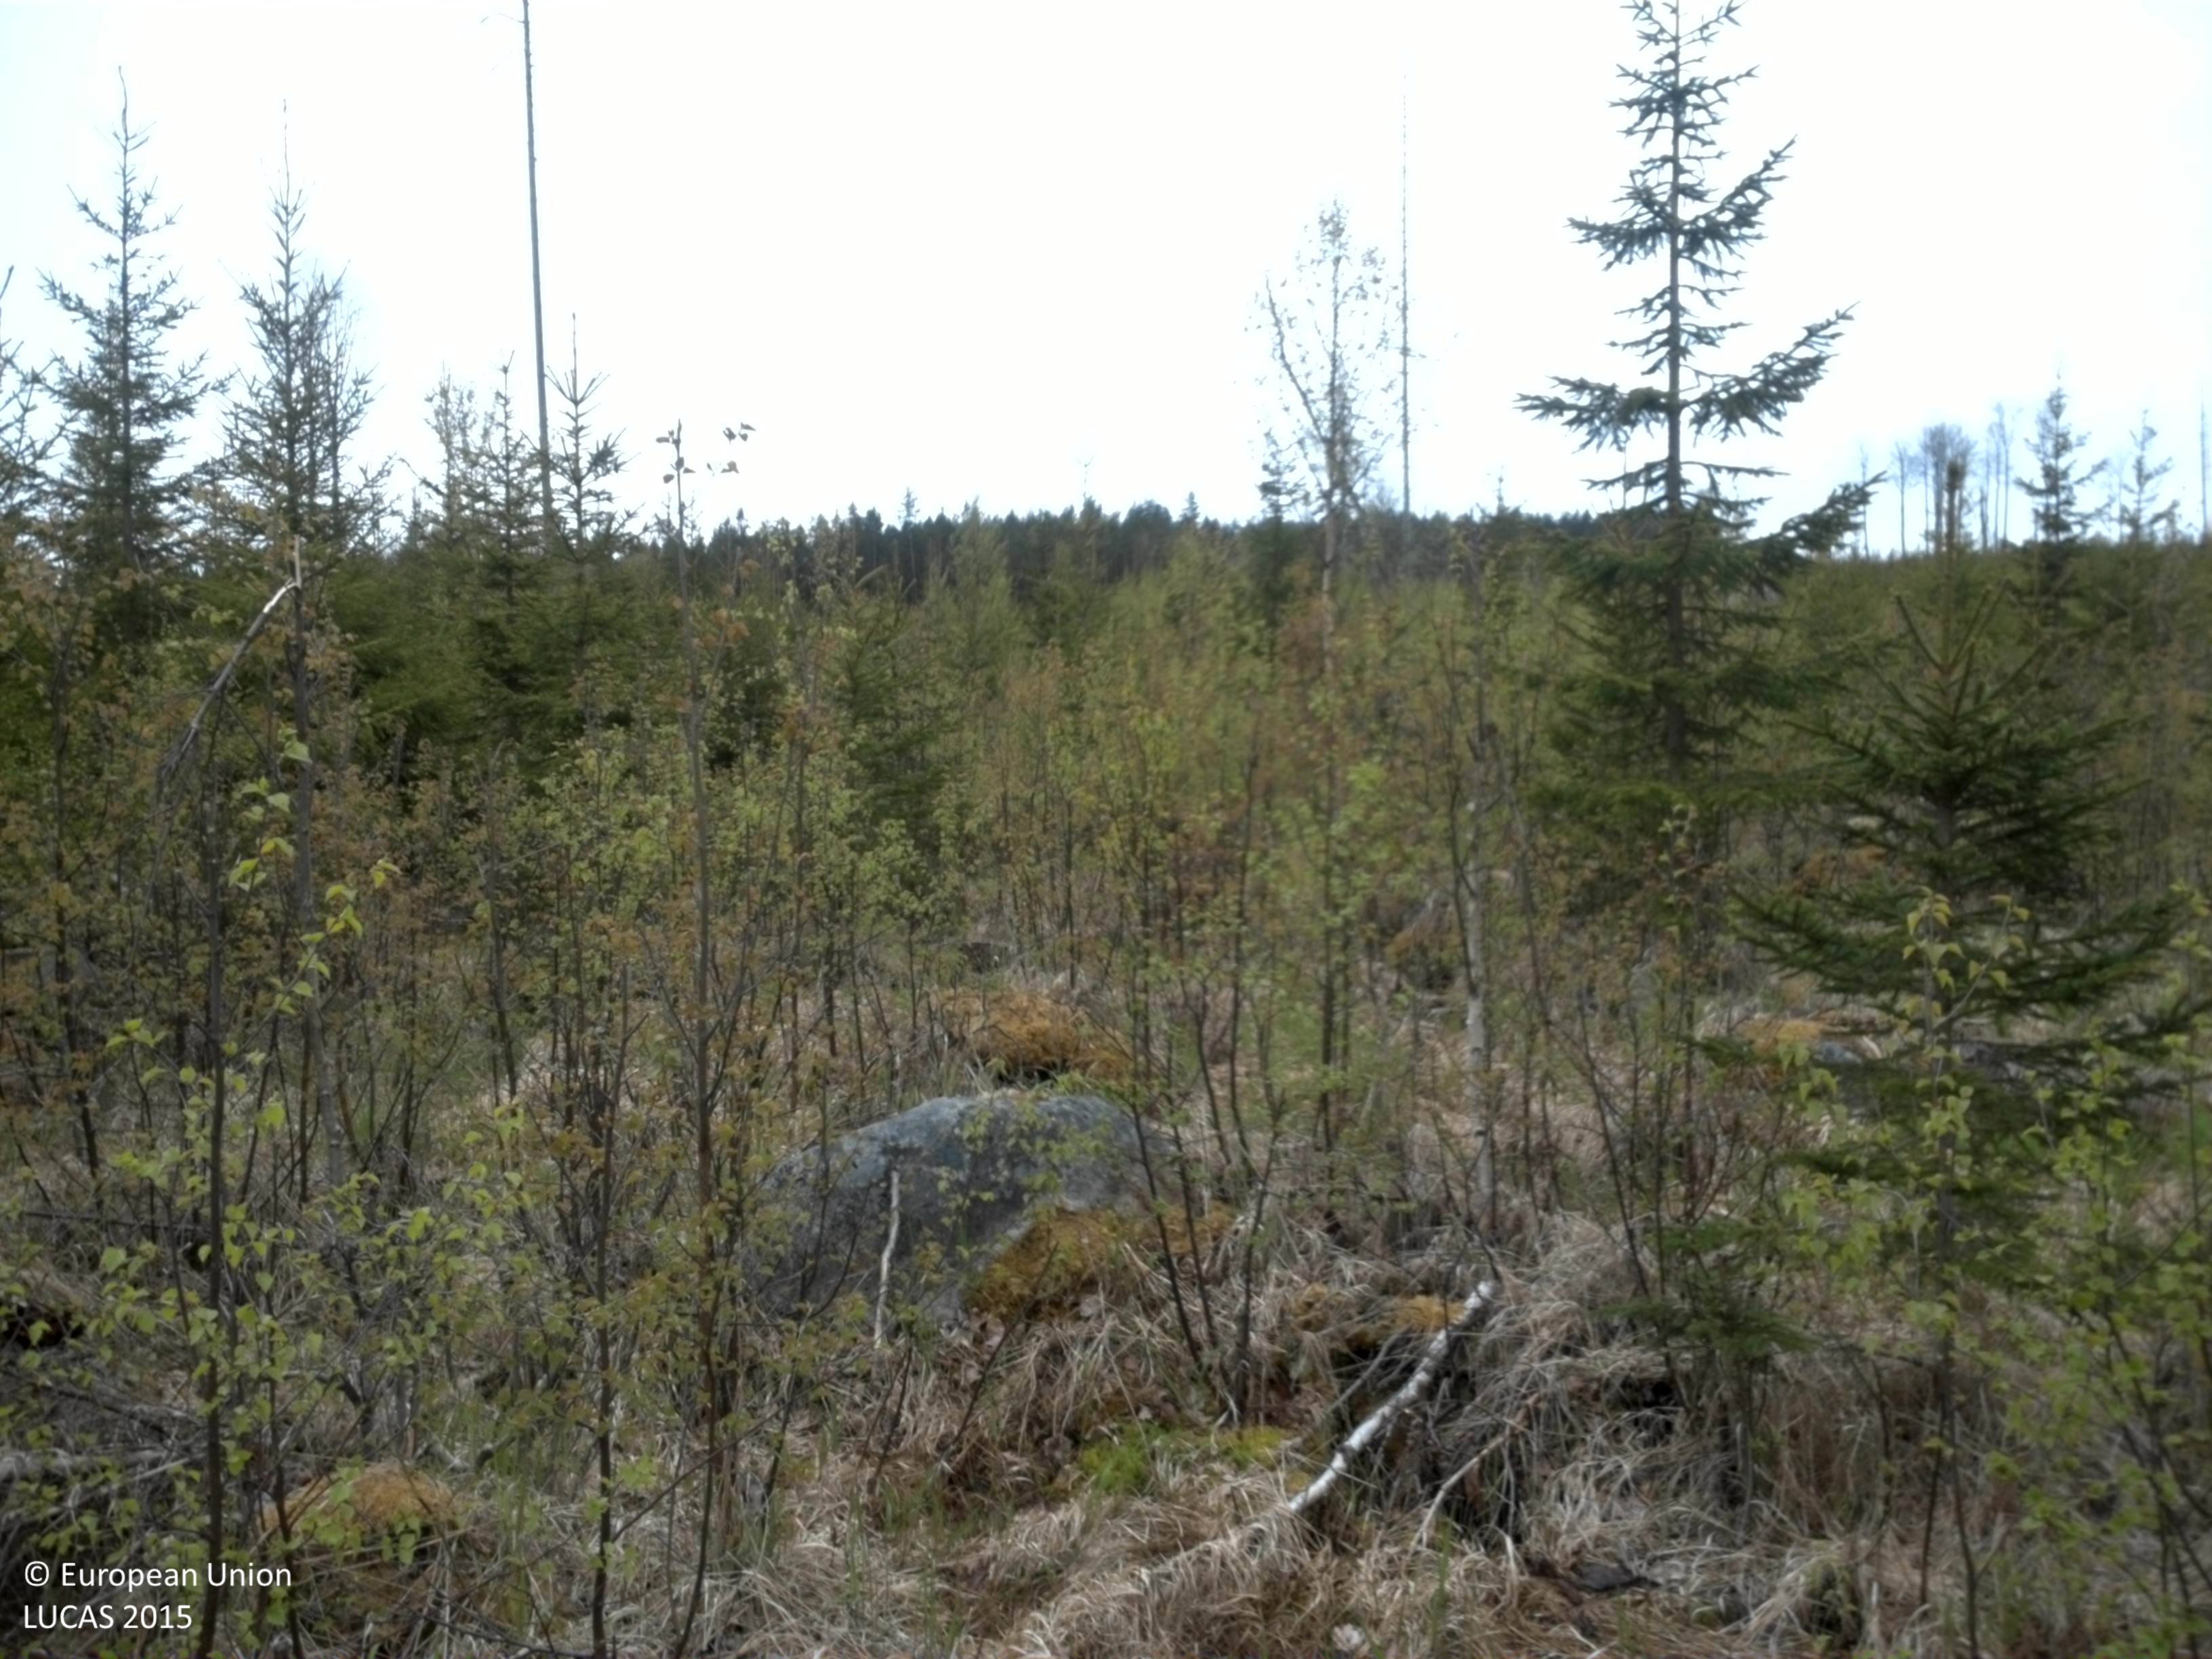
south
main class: Woodland
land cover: Spruce dominated mixed woodland
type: boreal forest
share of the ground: 50 - 75 %
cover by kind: coniferous forest trees 40 %, broadleaved forest trees 20 %, shrubs 20 %, herbaceous plants 20 %
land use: Forestry
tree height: < 5 m
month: May
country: SE
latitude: 60.9147
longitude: 12.5178
